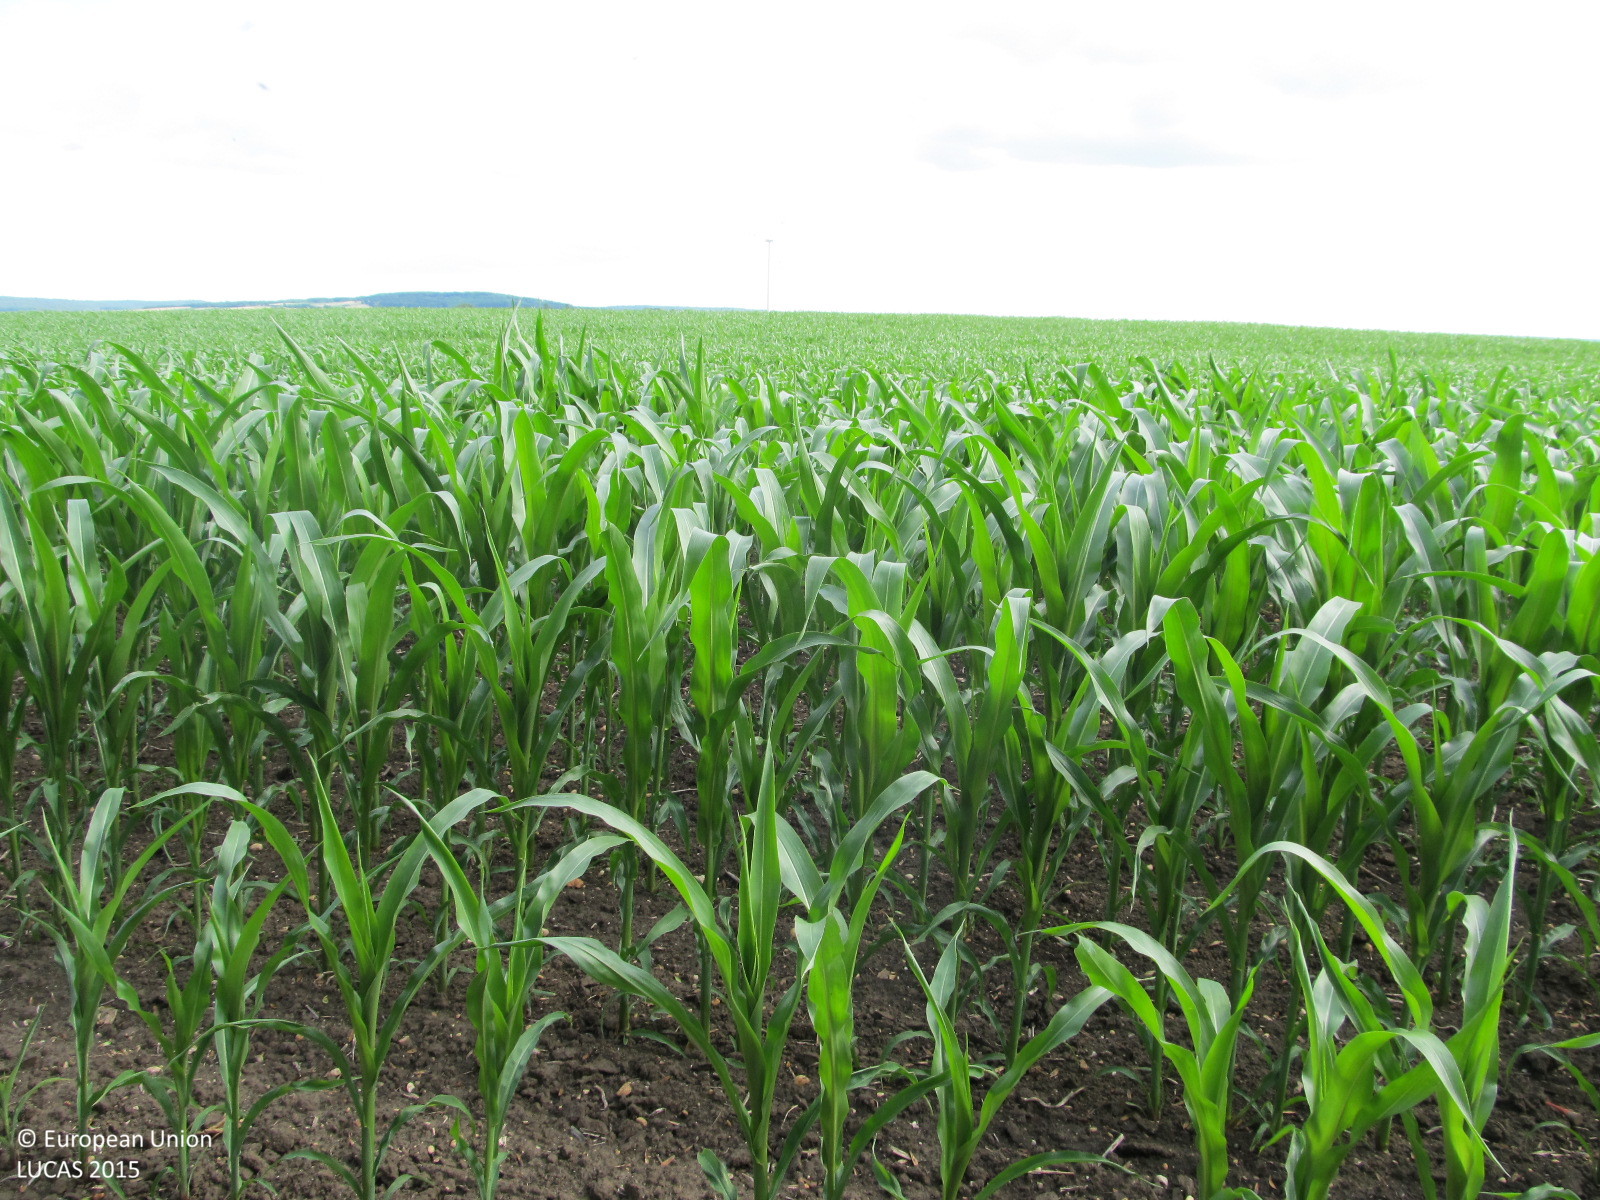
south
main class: Cropland
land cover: Maize
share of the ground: 50 - 75 %
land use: Agriculture (excluding fallow land and kitchen gardens)
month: June
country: AT
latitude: 48.6128
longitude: 16.1221
